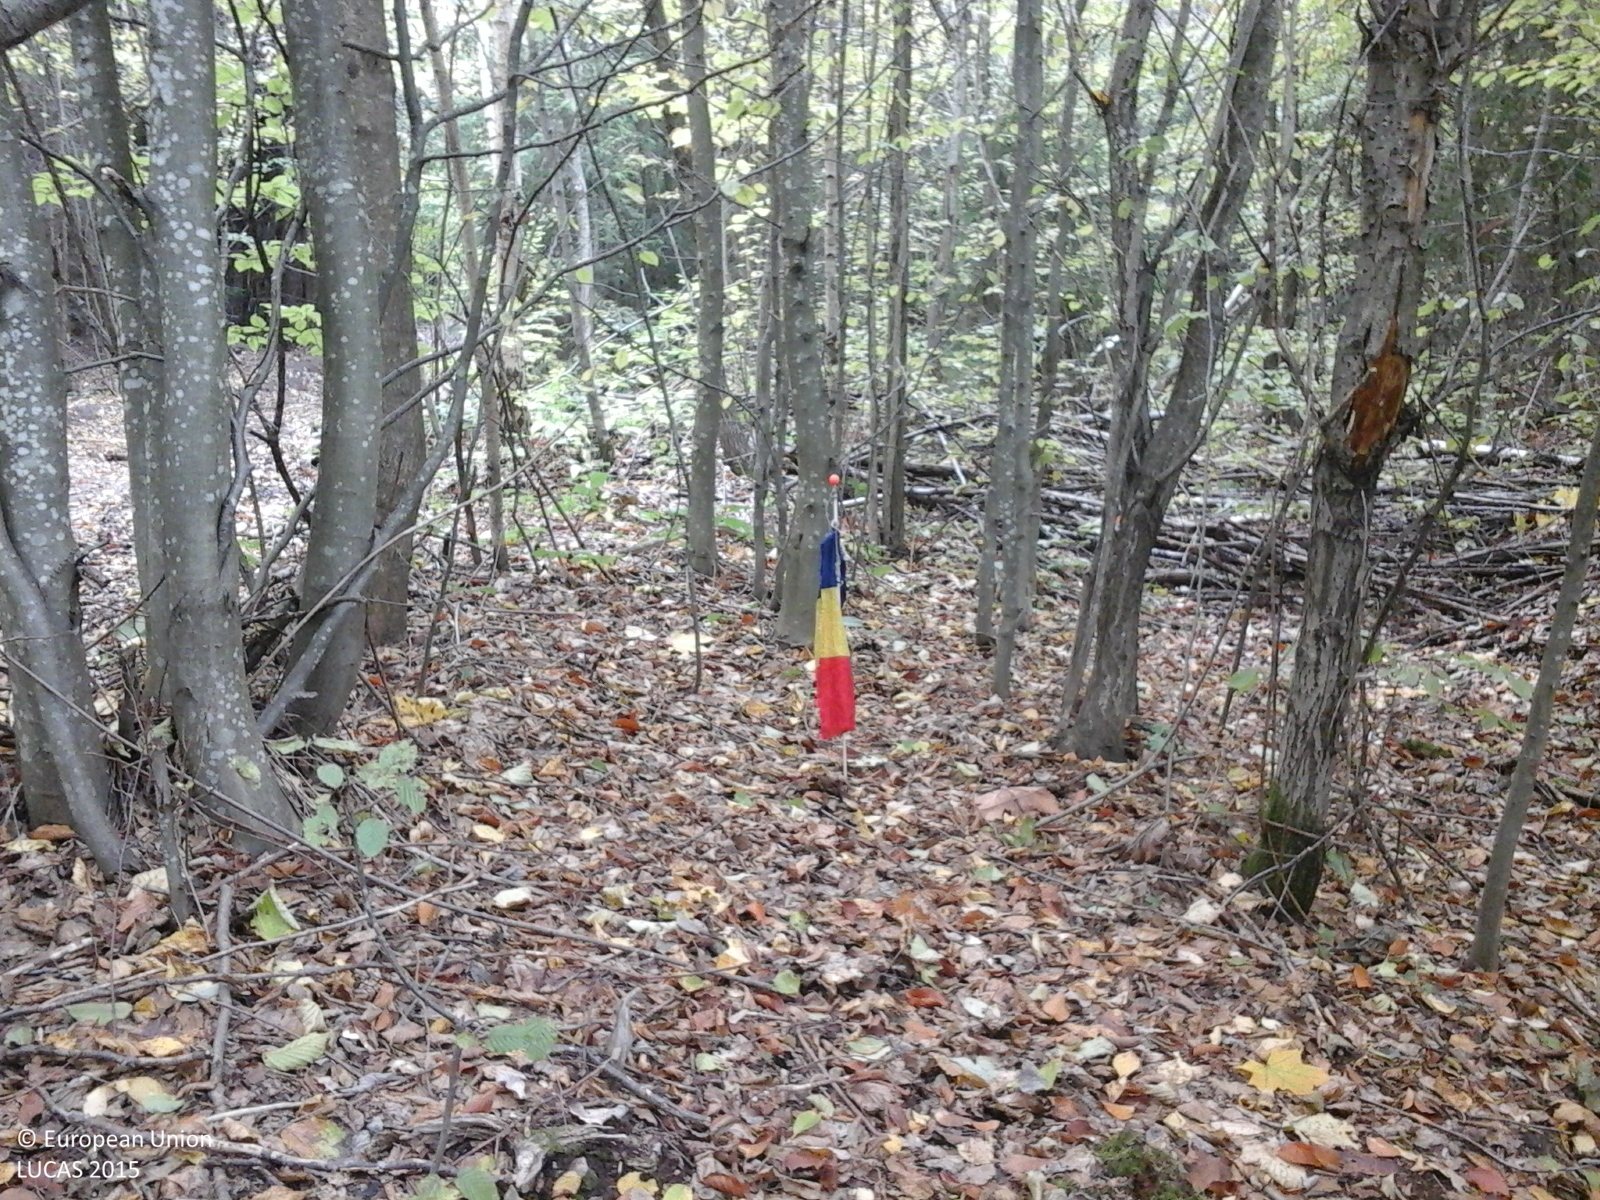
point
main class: Woodland
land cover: Broadleaved woodland
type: beech forest
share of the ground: > 75 %
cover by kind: broadleaved forest trees 100 %
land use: Forestry
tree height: > 5 m
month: October
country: RO
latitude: 46.4609
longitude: 25.4859
